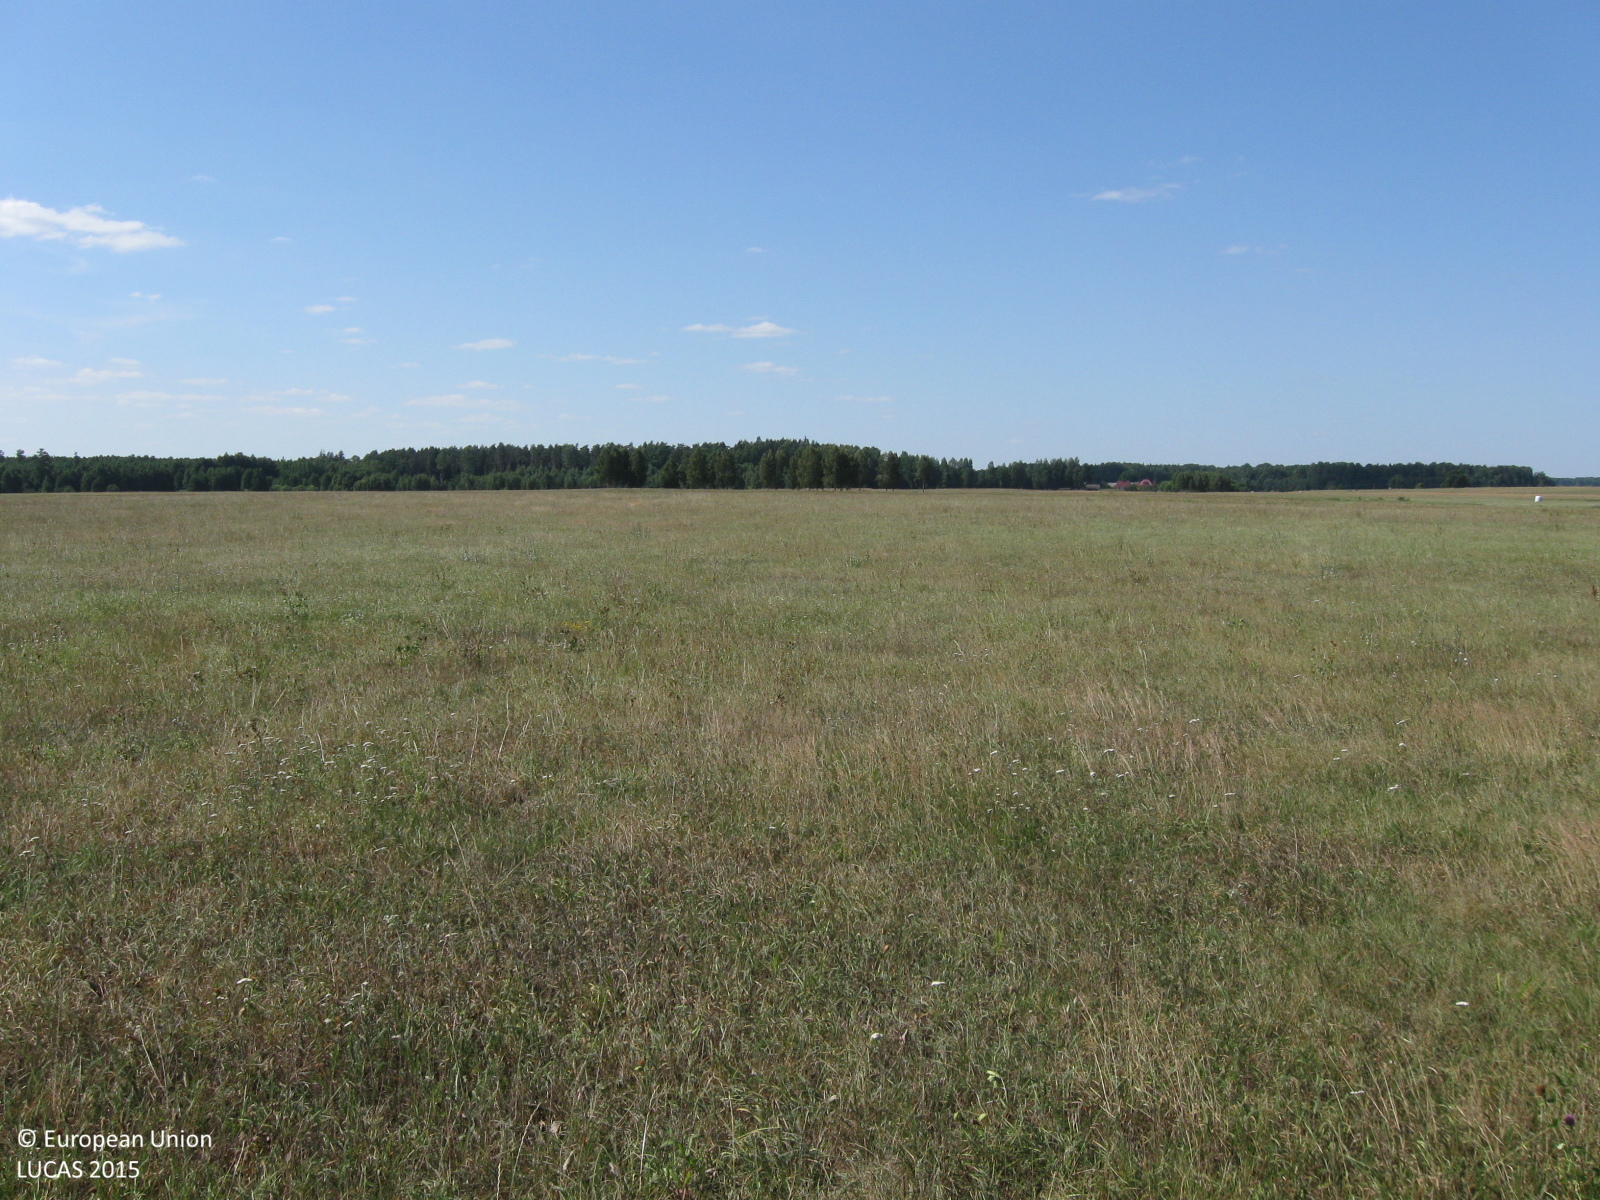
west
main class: Grassland
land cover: Grassland without tree/shrub cover
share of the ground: > 75 %
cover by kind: herbaceous plants 100 %
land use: Agriculture (excluding fallow land and kitchen gardens)
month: August
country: LT
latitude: 55.3367
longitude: 22.5005
